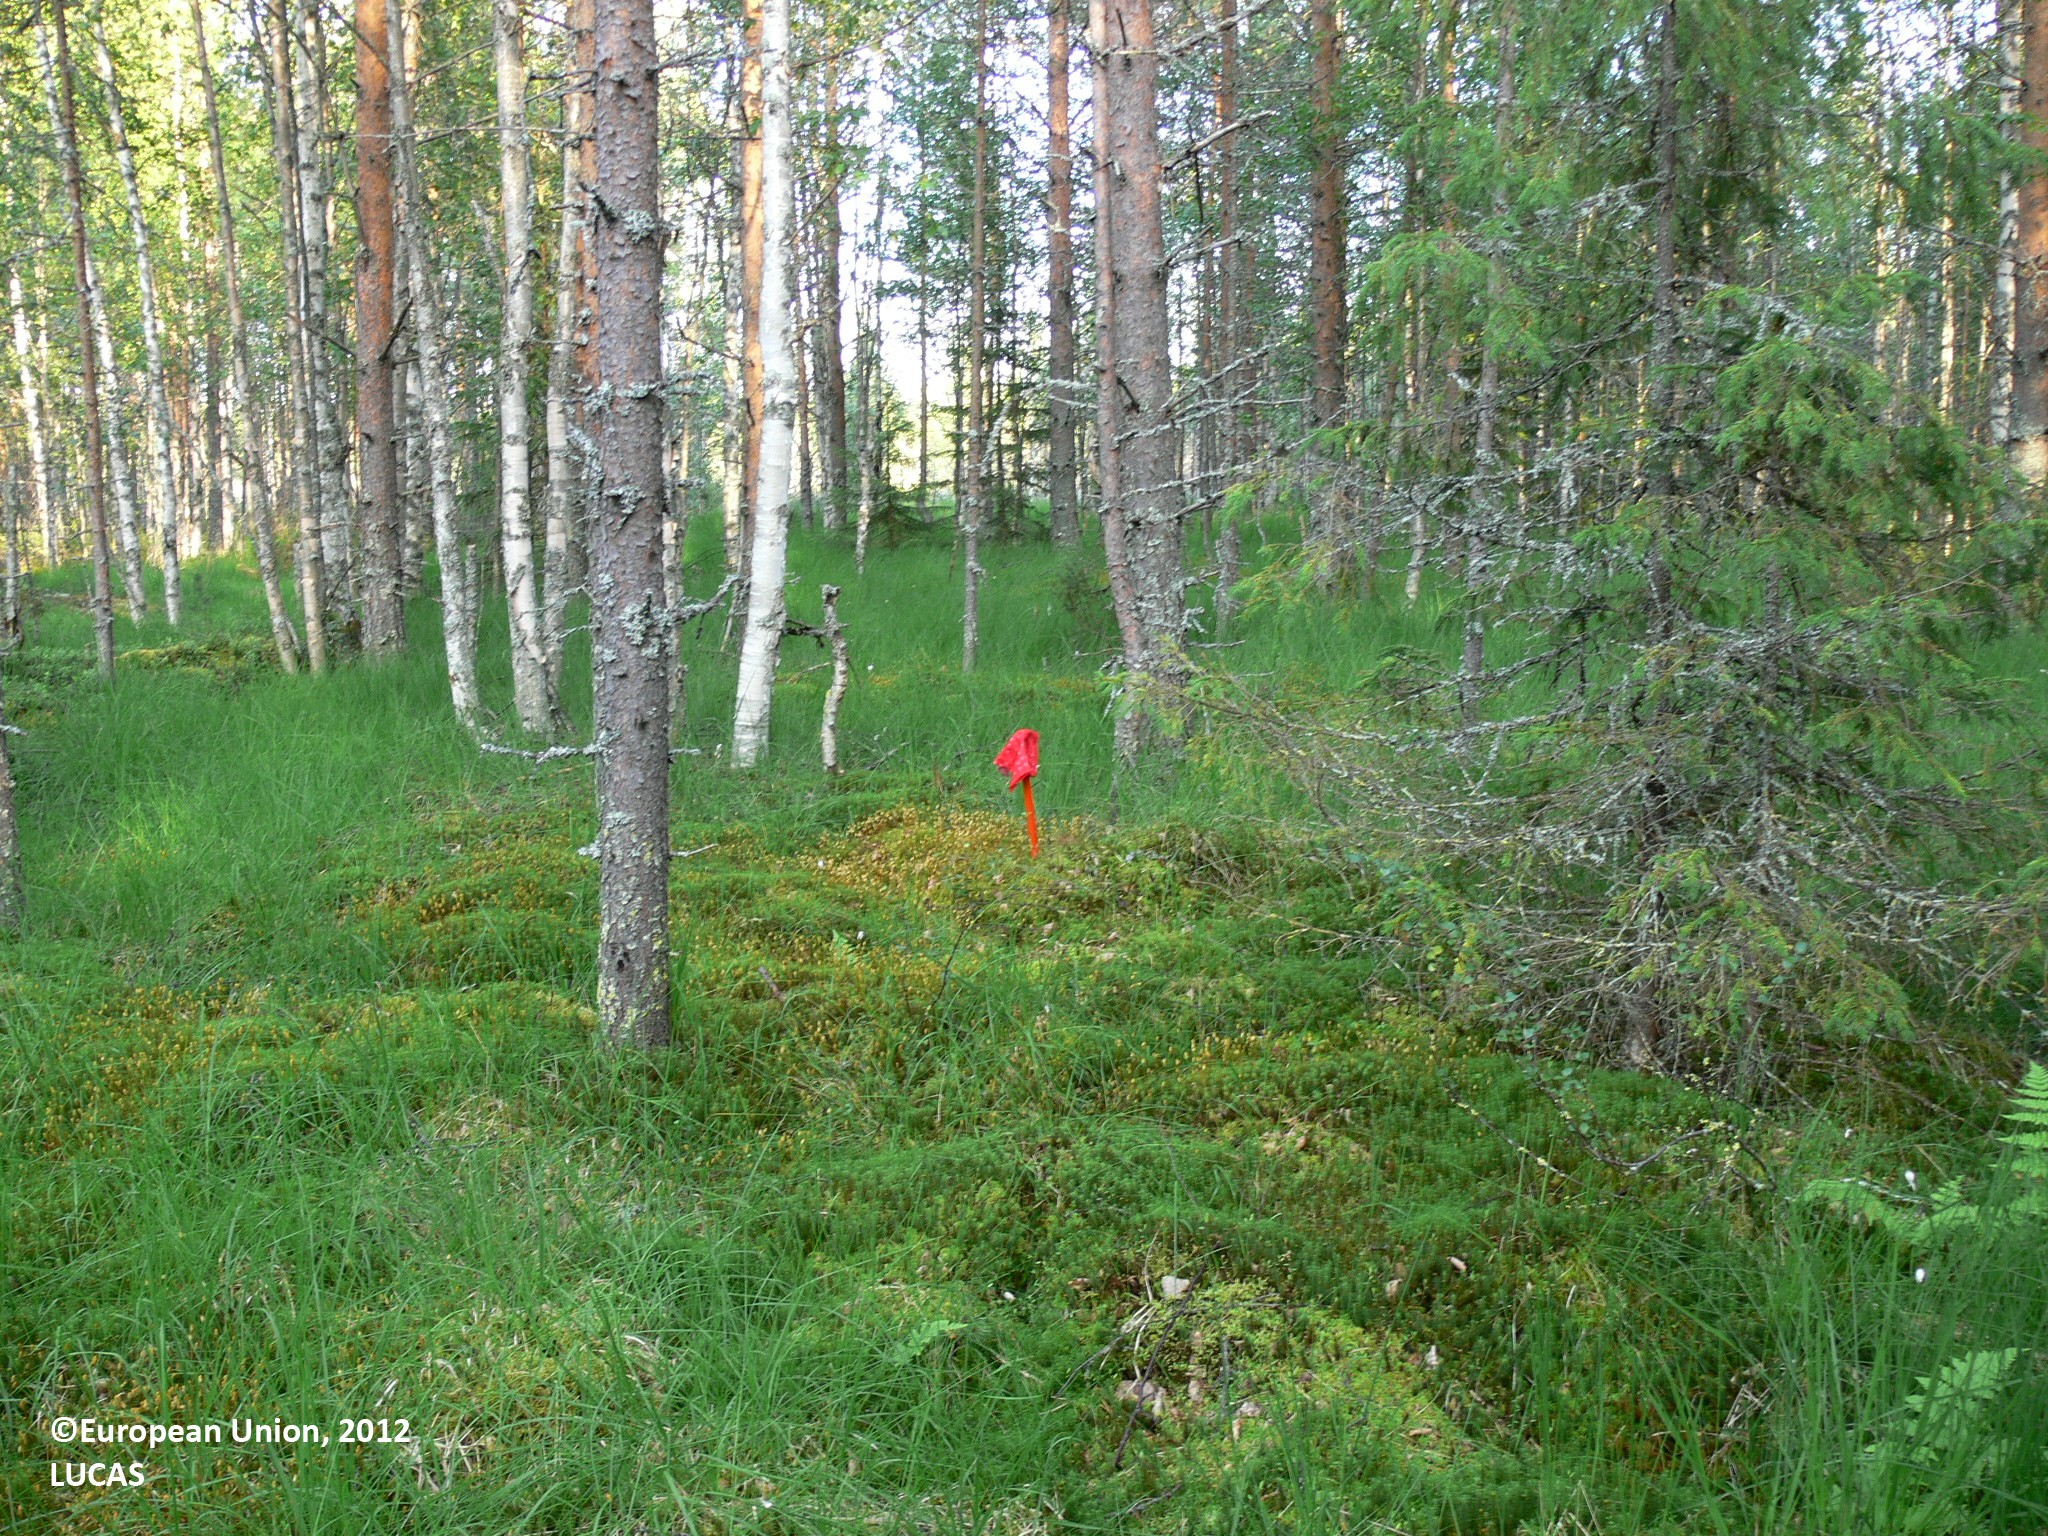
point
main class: Woodland
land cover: Pine dominated mixed woodland
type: boreal forest
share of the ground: > 75 %
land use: Forestry
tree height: > 5 m
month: July
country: FI
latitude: 63.3262
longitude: 30.8331
